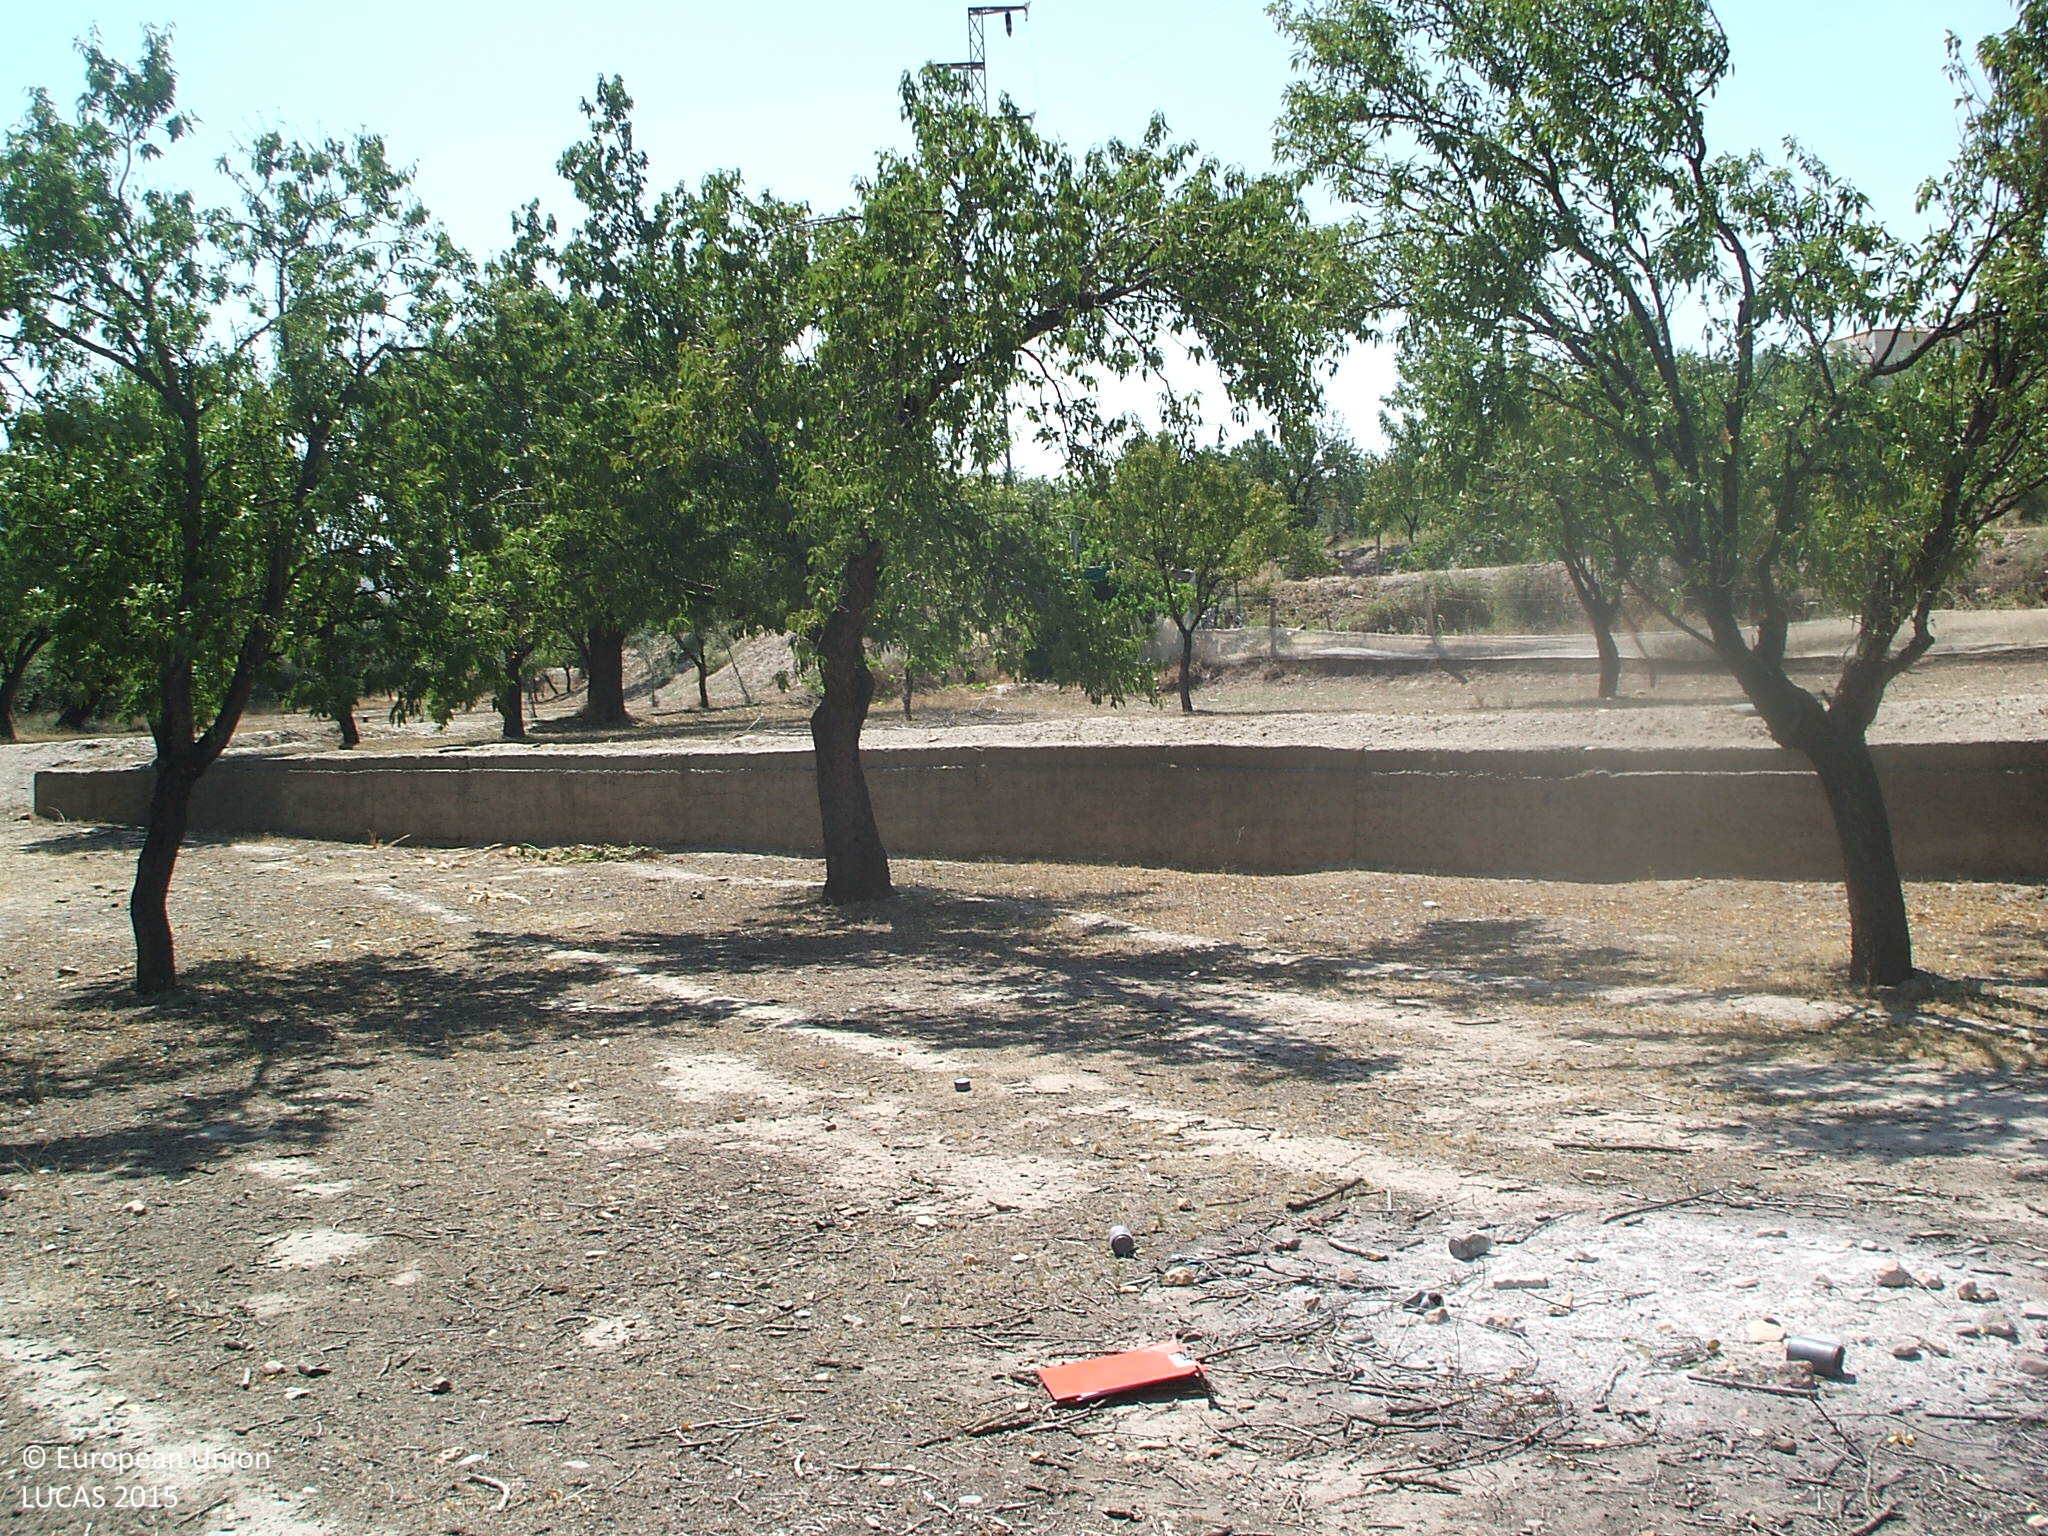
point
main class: Cropland
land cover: Nuts trees
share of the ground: 50 - 75 %
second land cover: Other bare soil
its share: > 75 %
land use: Agriculture (excluding fallow land and kitchen gardens)
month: June
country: ES
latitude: 37.1677
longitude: -2.8324
